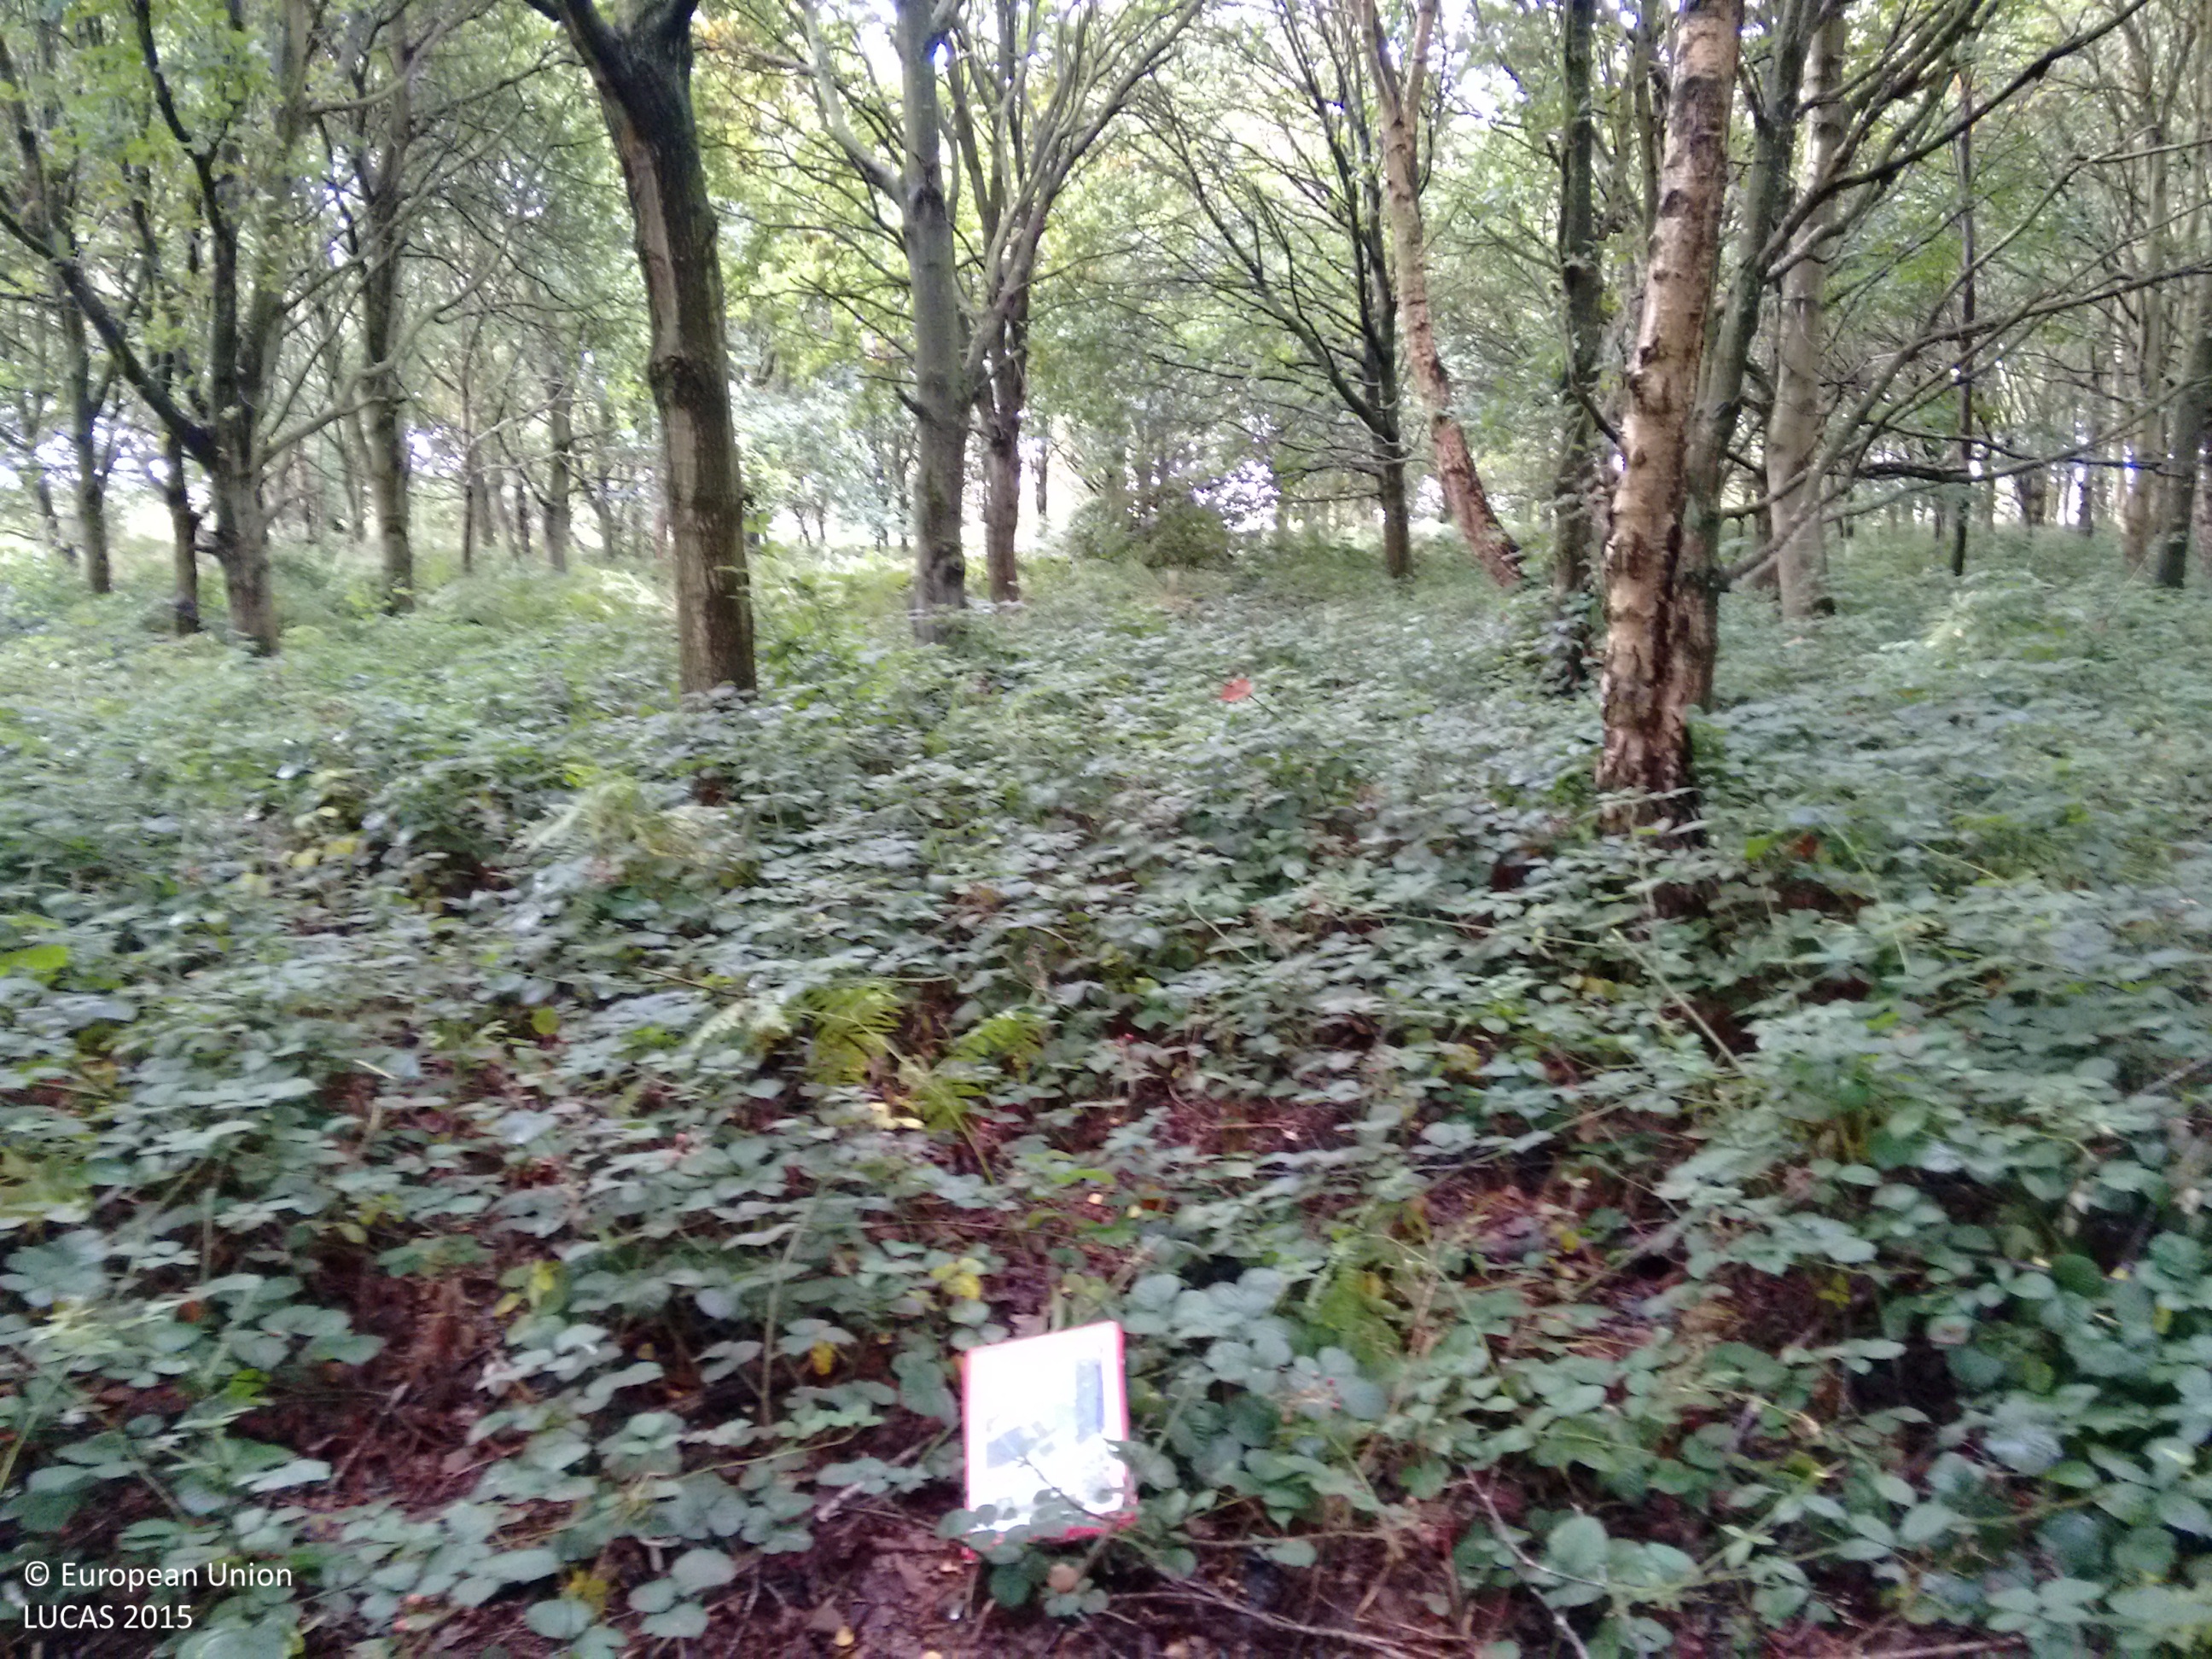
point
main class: Woodland
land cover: Broadleaved woodland
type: mesophytic deciduous forest
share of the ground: > 75 %
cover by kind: broadleaved forest trees 100 %
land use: Semi-natural and natural areas not in use
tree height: > 5 m
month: September
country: GB
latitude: 52.7928
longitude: 1.2146
